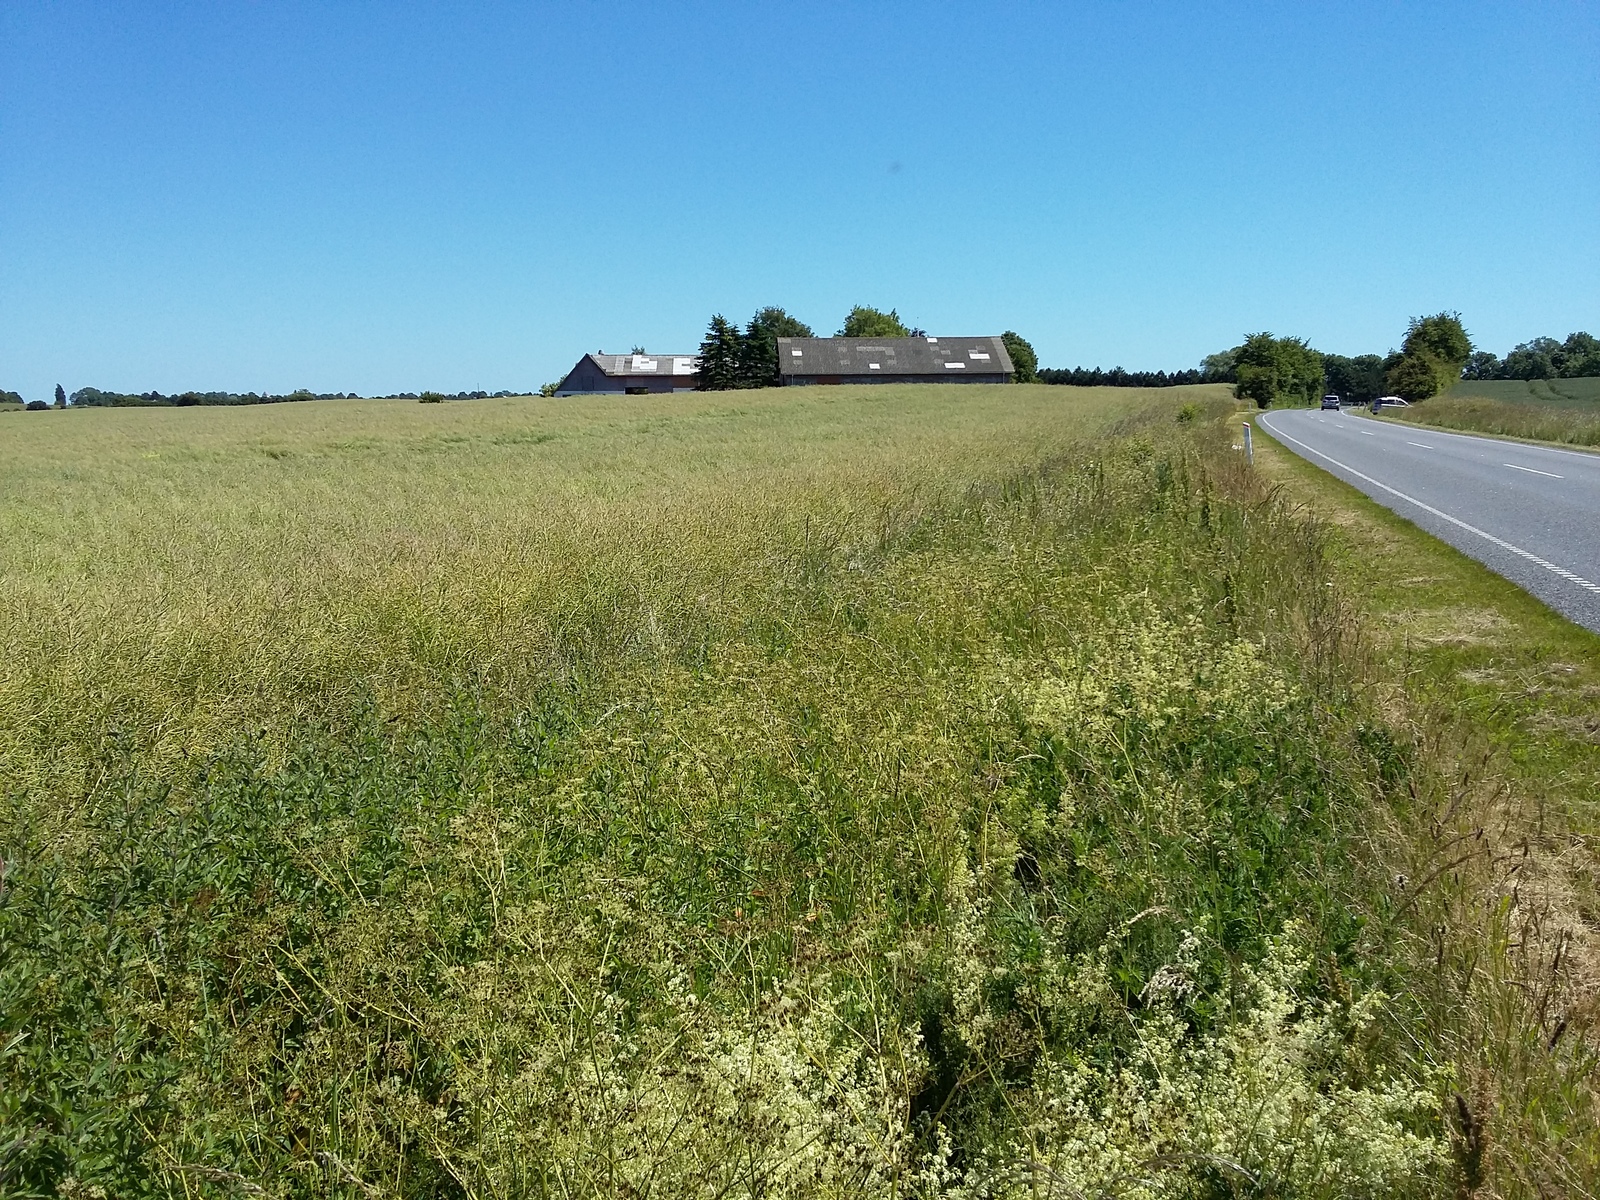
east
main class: Cropland
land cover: Rape and turnip rape
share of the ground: > 75 %
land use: Agriculture (excluding fallow land and kitchen gardens)
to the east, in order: Rape and turnip rape
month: July
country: DK
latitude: 54.9314
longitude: 12.0119
